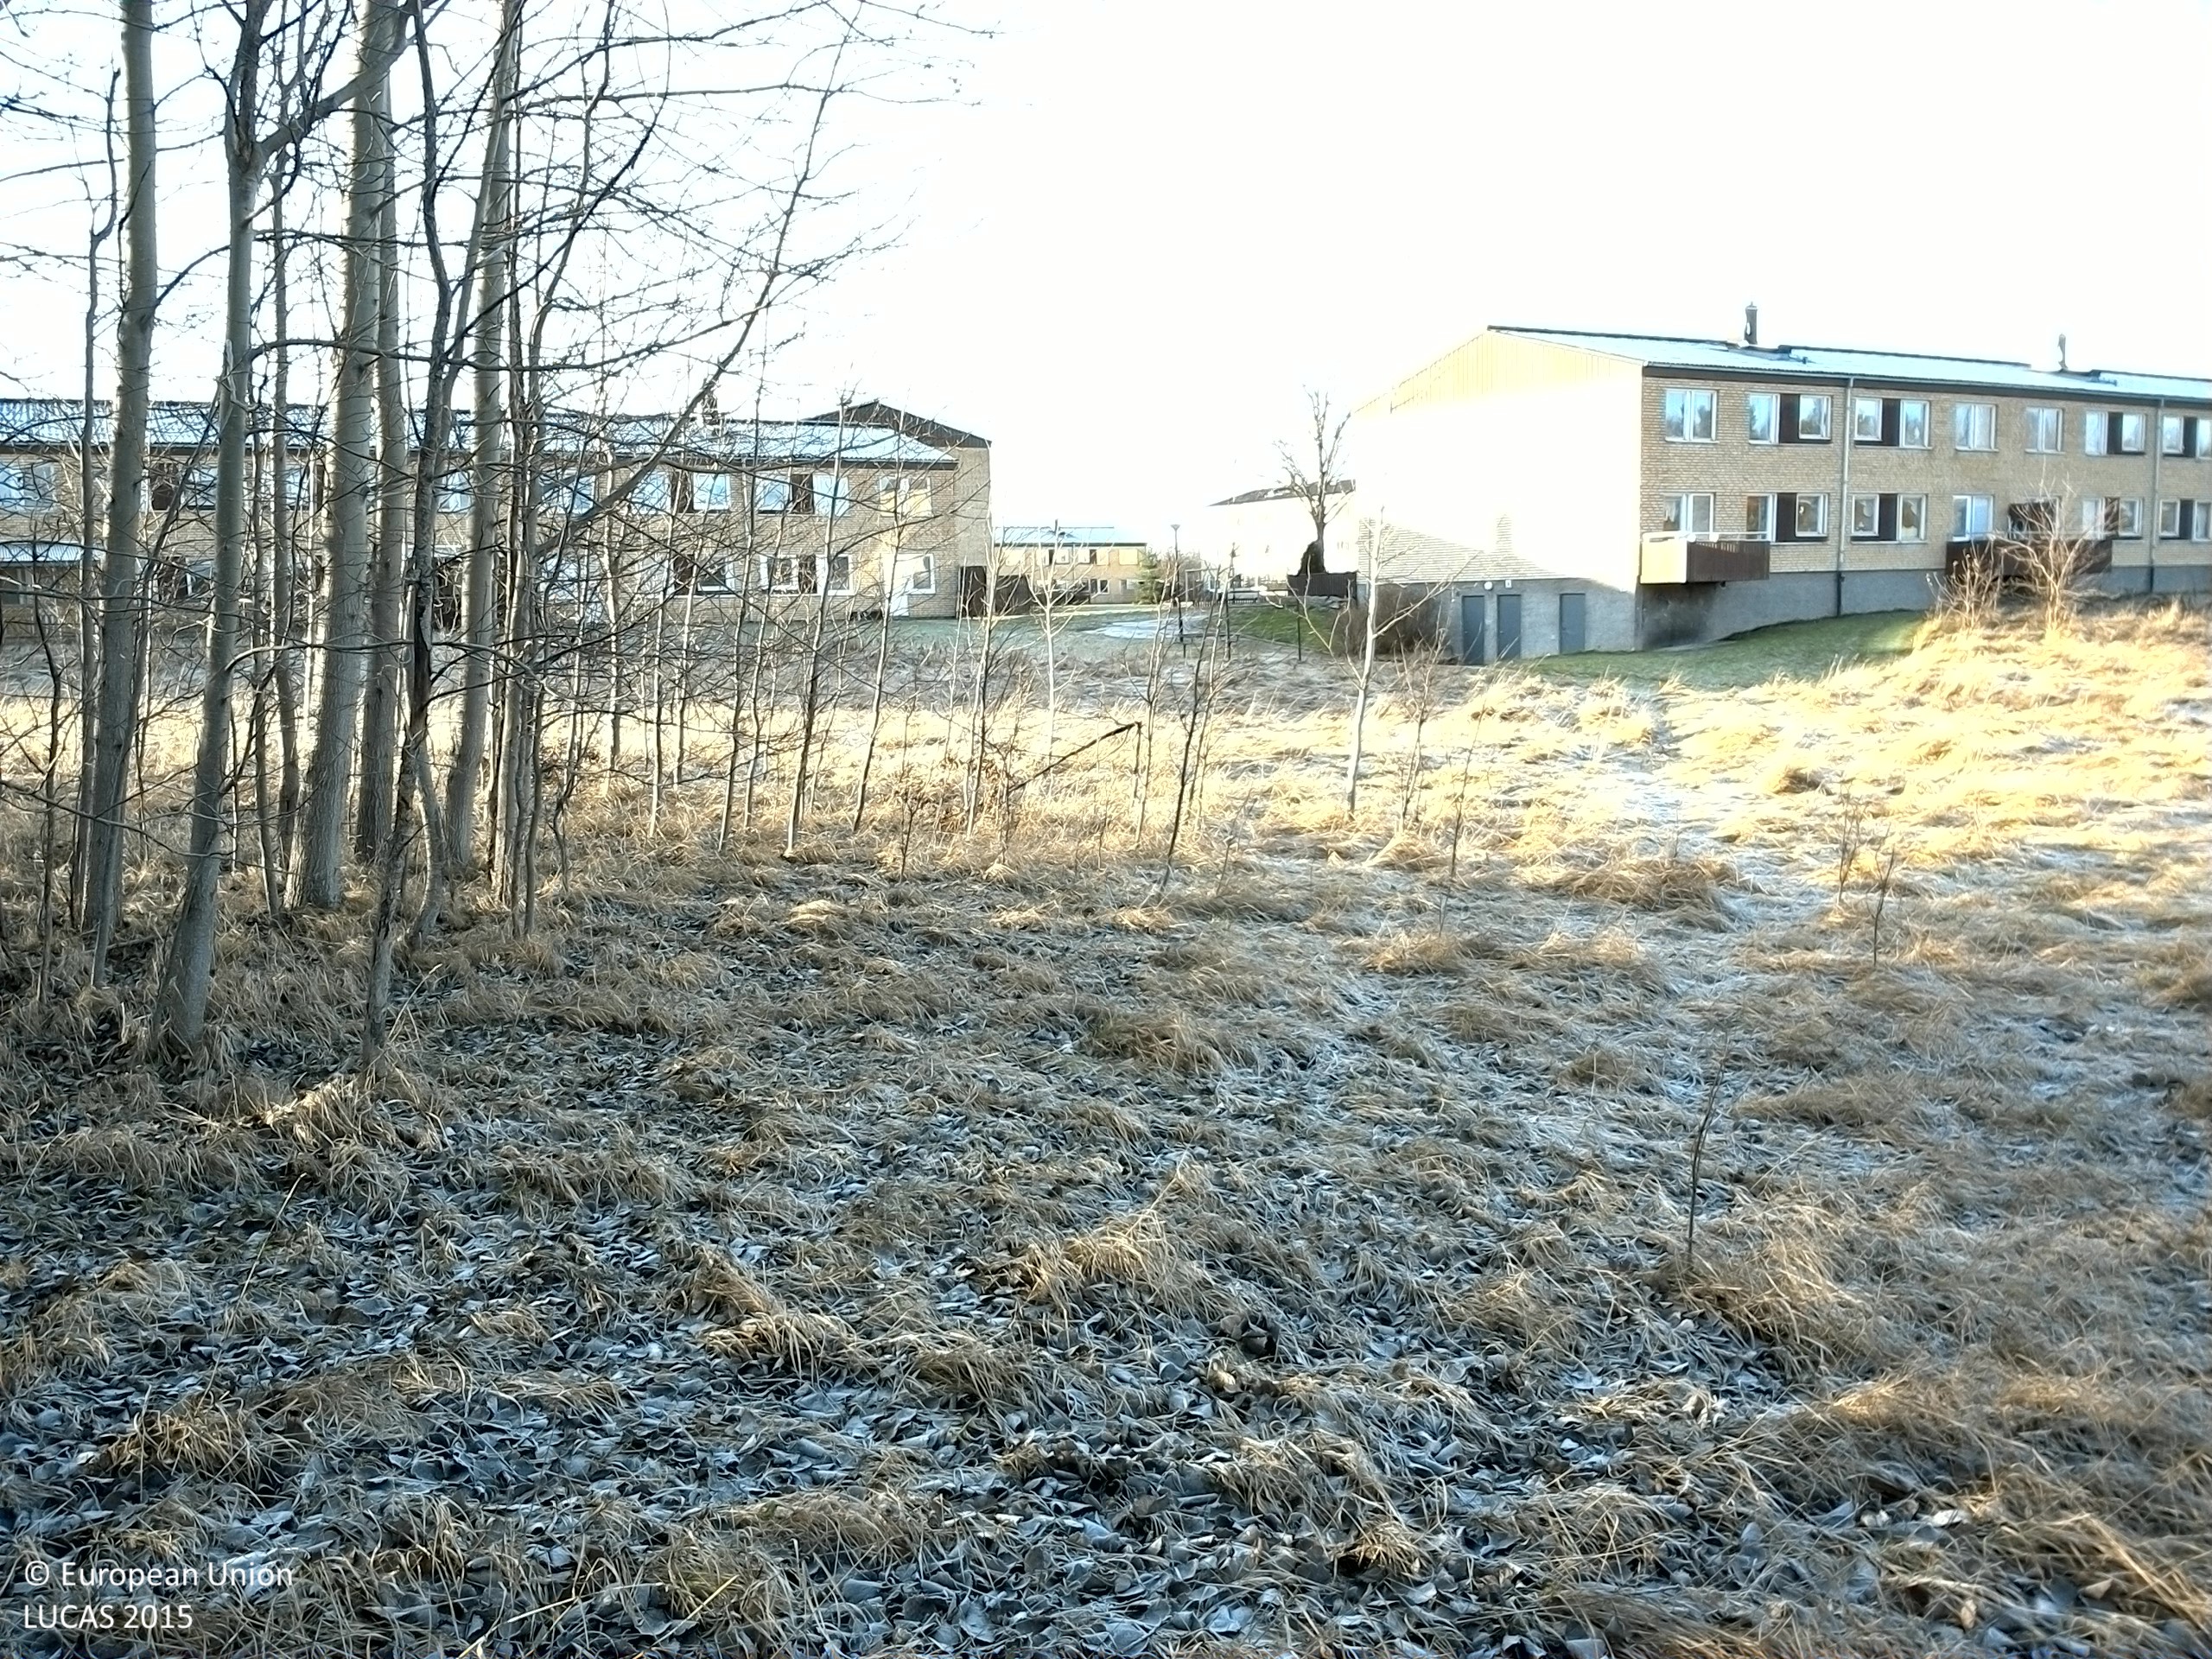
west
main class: Grassland
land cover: Grassland with sparse tree/shrub cover
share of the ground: > 75 %
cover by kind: herbaceous plants 90 %, broadleaved forest trees 5 %, shrubs 5 %
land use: Fallow land
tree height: > 5 m
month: December
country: SE
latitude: 59.4168
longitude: 16.4949
